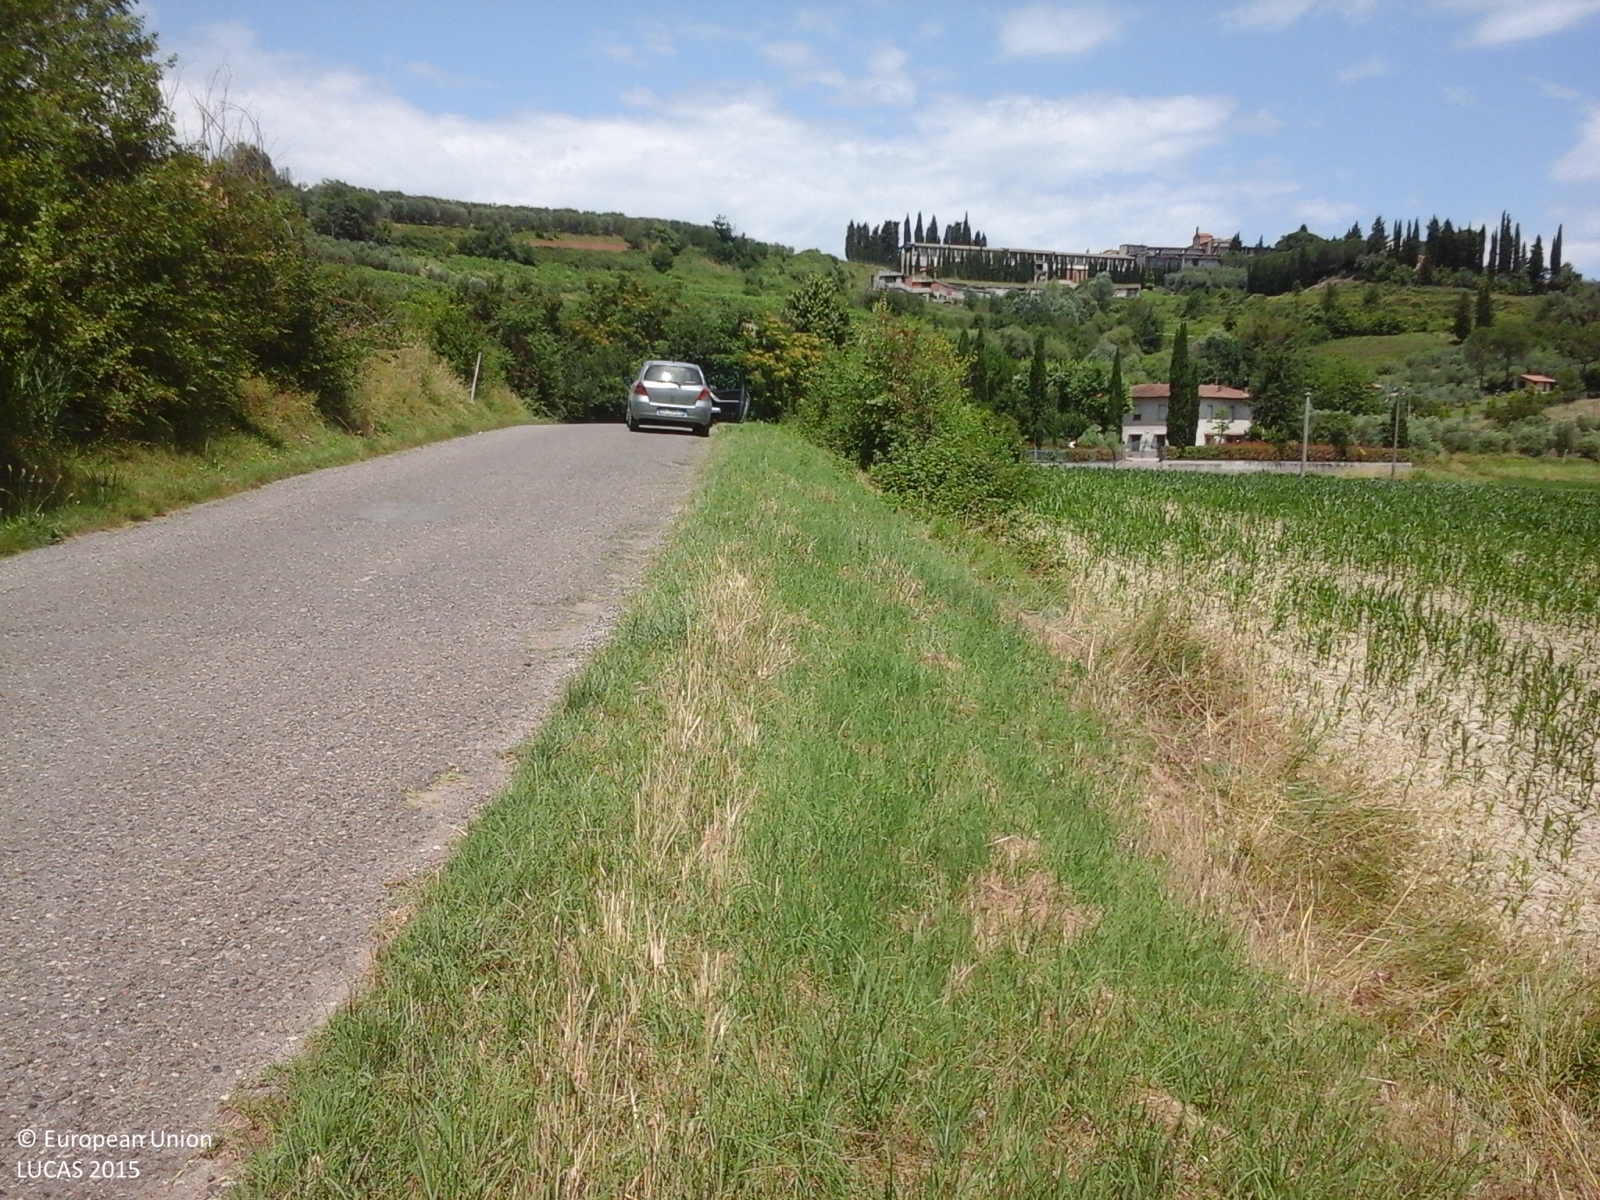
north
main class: Cropland
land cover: Maize
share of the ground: > 75 %
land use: Agriculture (excluding fallow land and kitchen gardens)
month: June
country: IT
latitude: 43.6062
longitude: 10.9761
